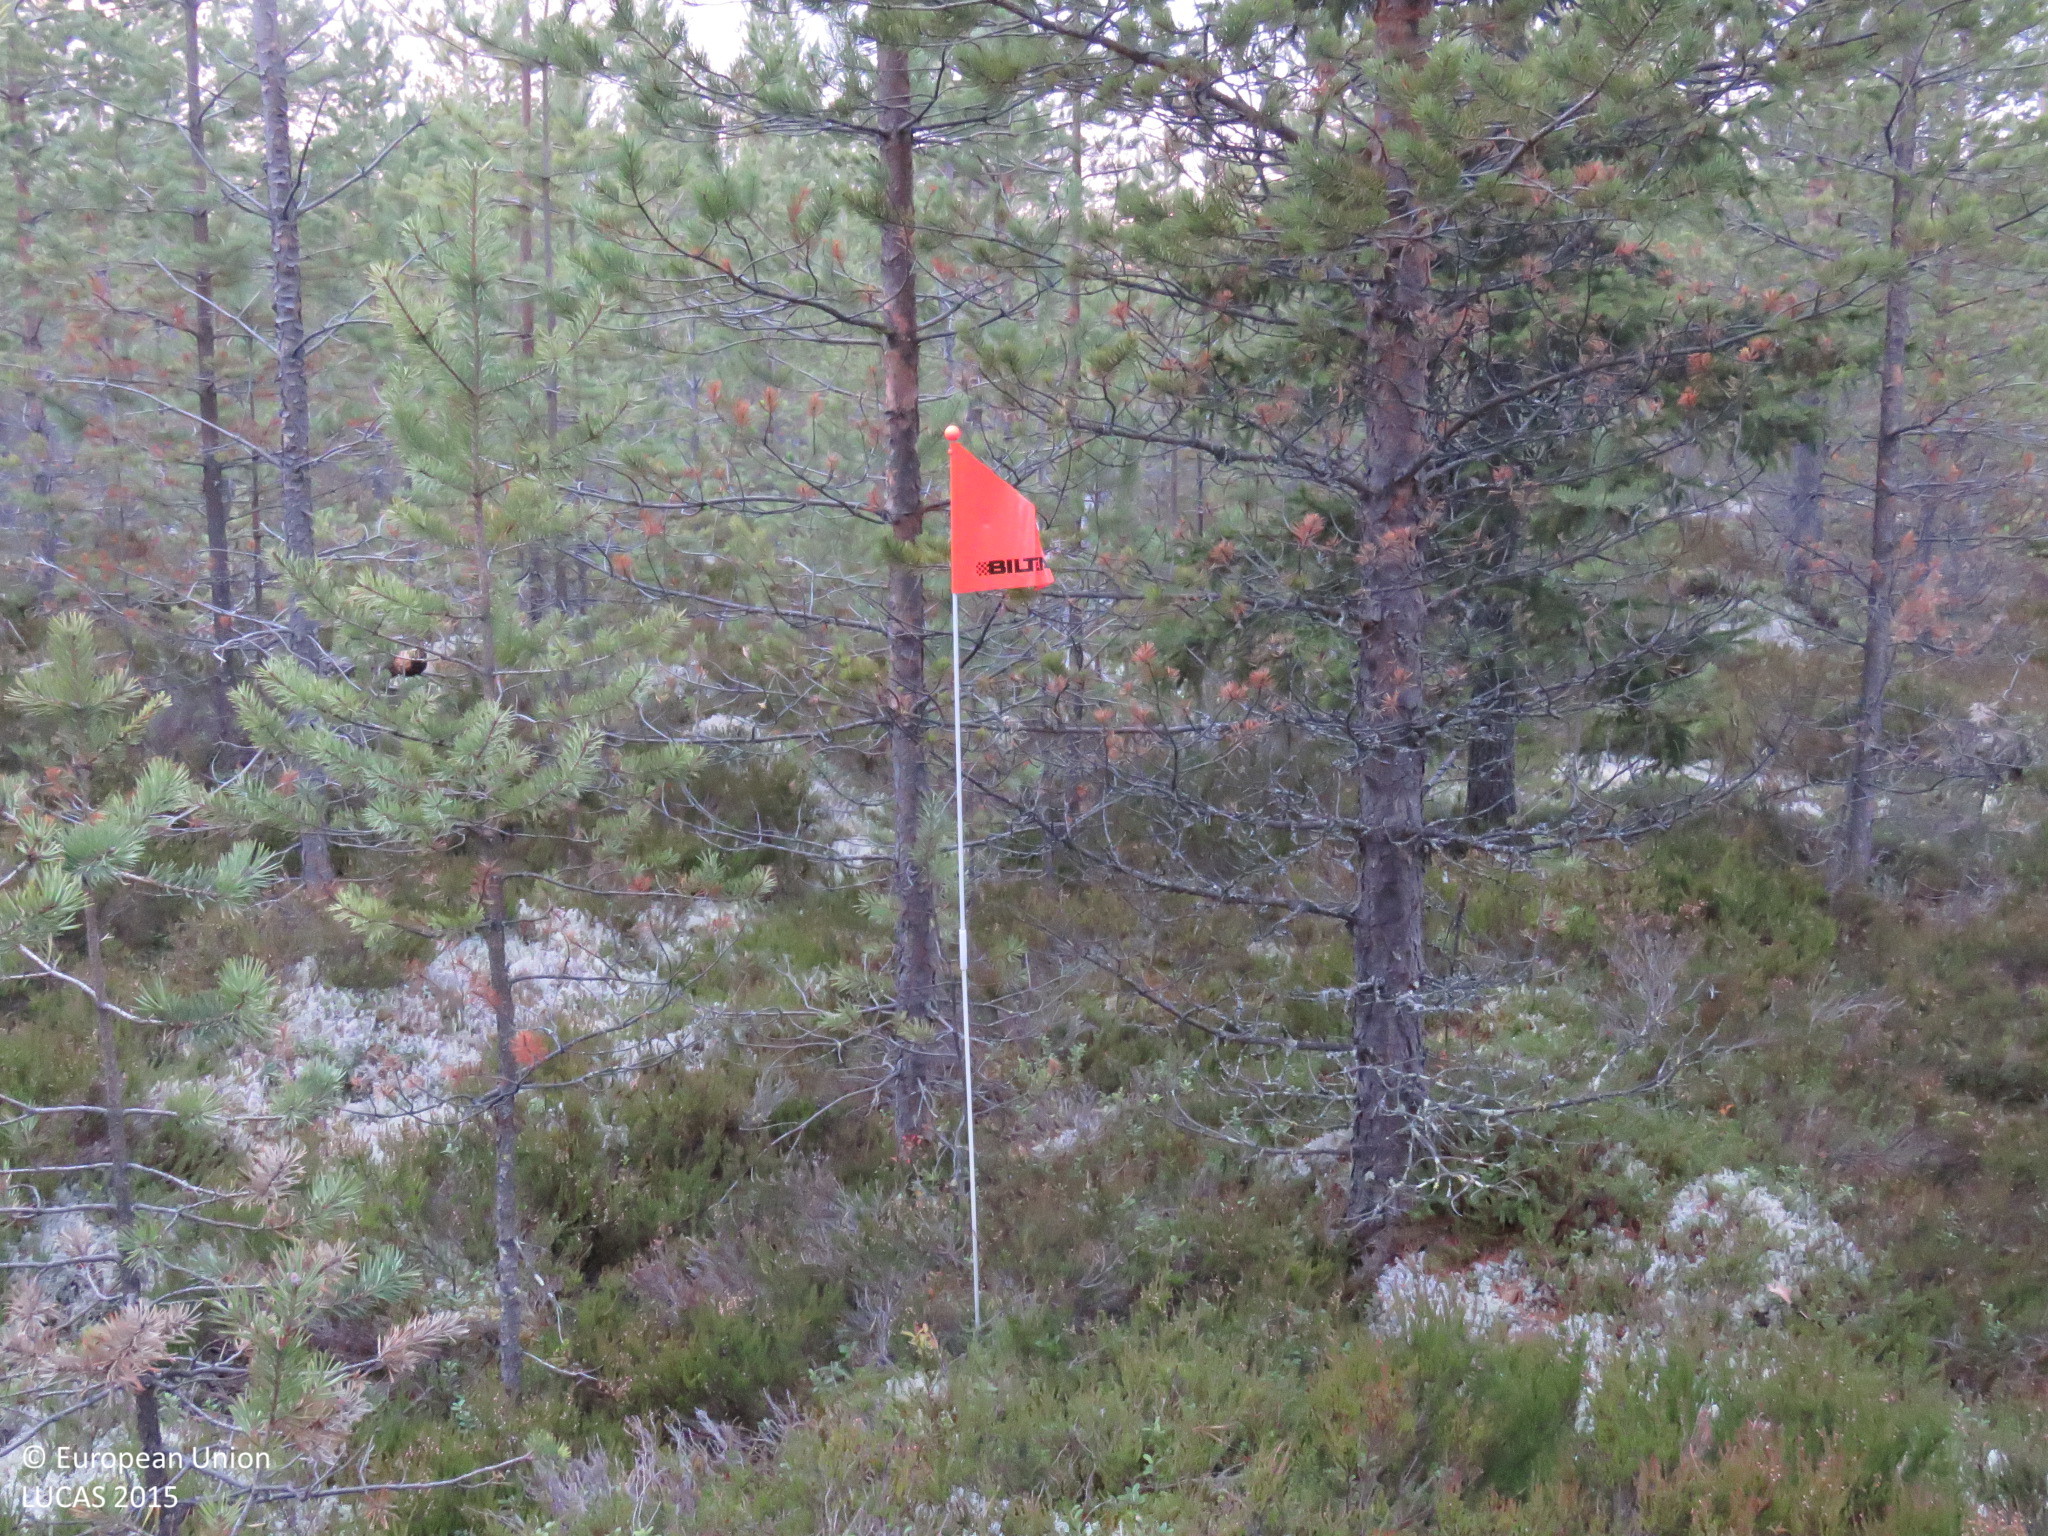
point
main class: Woodland
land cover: Pine dominated coniferous woodland
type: boreal forest
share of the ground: > 75 %
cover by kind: coniferous forest trees 70 %, shrubs 15 %, broadleaved forest trees 5 %, herbaceous plants 5 %, lichens and mosses 5 %
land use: Forestry
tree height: > 5 m
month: October
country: FI
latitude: 64.7567
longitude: 27.1305
